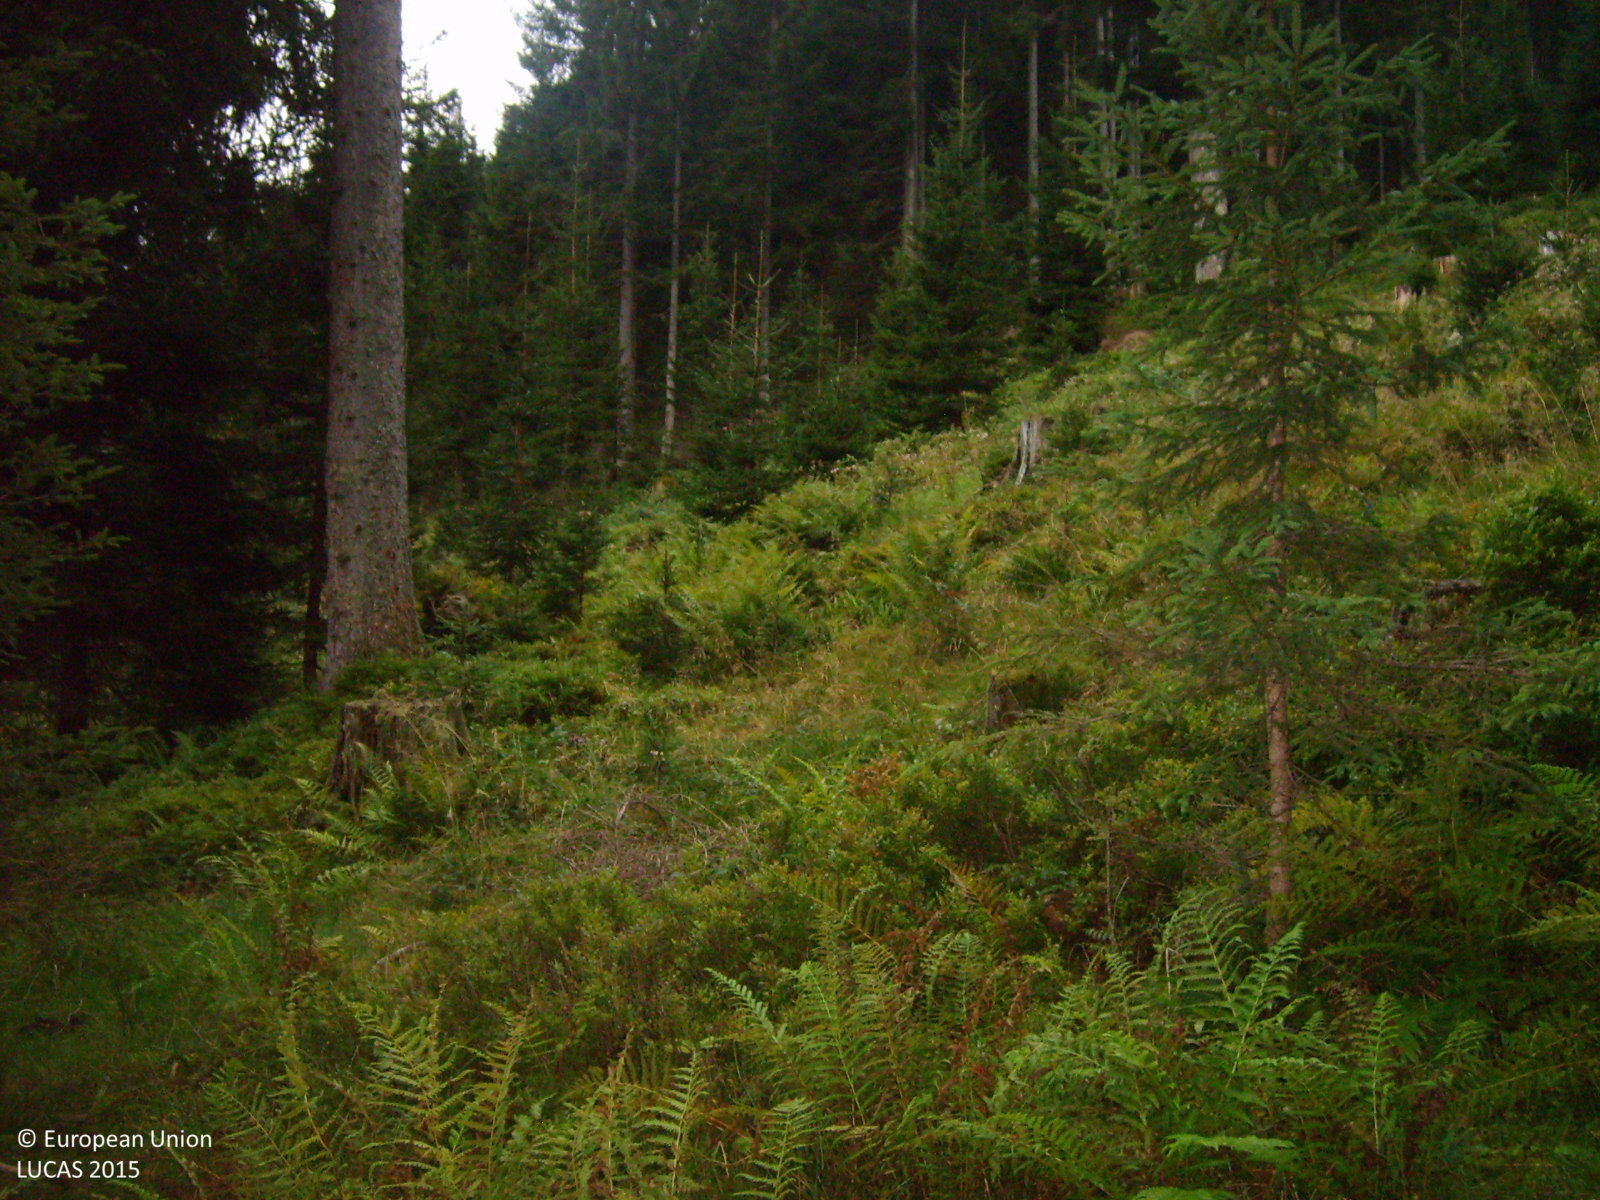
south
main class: Woodland
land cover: Spruce dominated coniferous woodland
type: alpine coniferous forest
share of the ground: 50 - 75 %
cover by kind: coniferous forest trees 55 %, shrubs 35 %, lichens and mosses 10 %
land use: Forestry
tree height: > 5 m
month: September
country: AT
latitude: 47.4487
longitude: 13.4598
